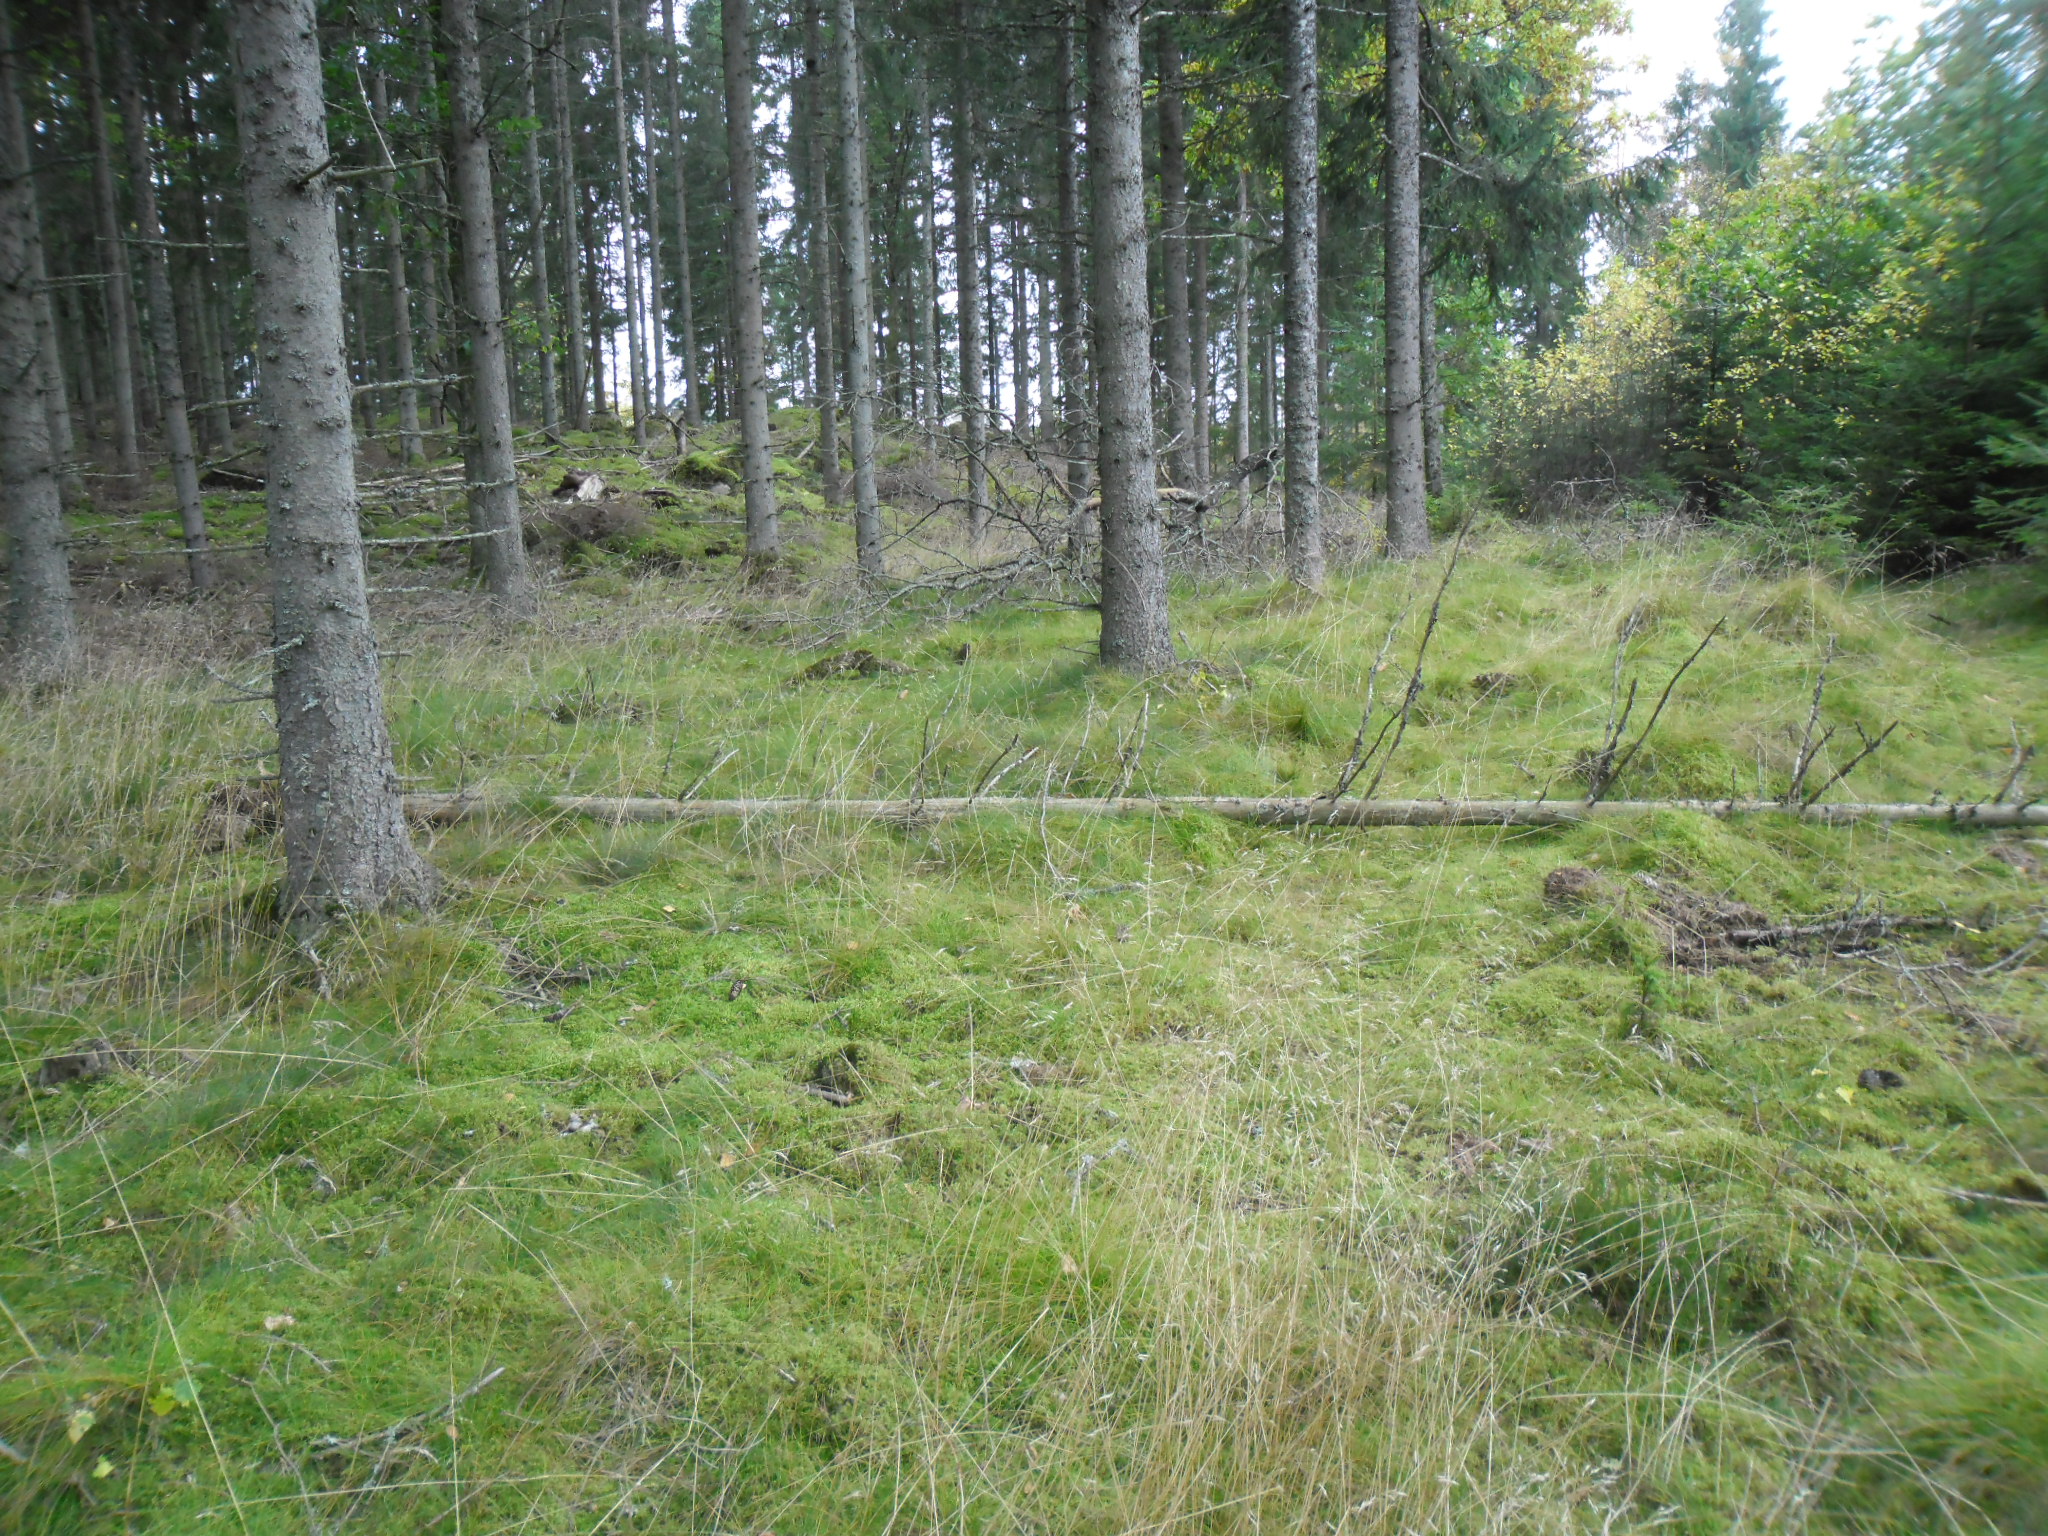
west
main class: Woodland
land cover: Spruce dominated coniferous woodland
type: boreal forest
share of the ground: > 75 %
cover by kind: coniferous forest trees 80 %, lichens and mosses 20 %
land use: Forestry
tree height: > 5 m
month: October
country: SE
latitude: 56.4125
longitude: 14.0331
